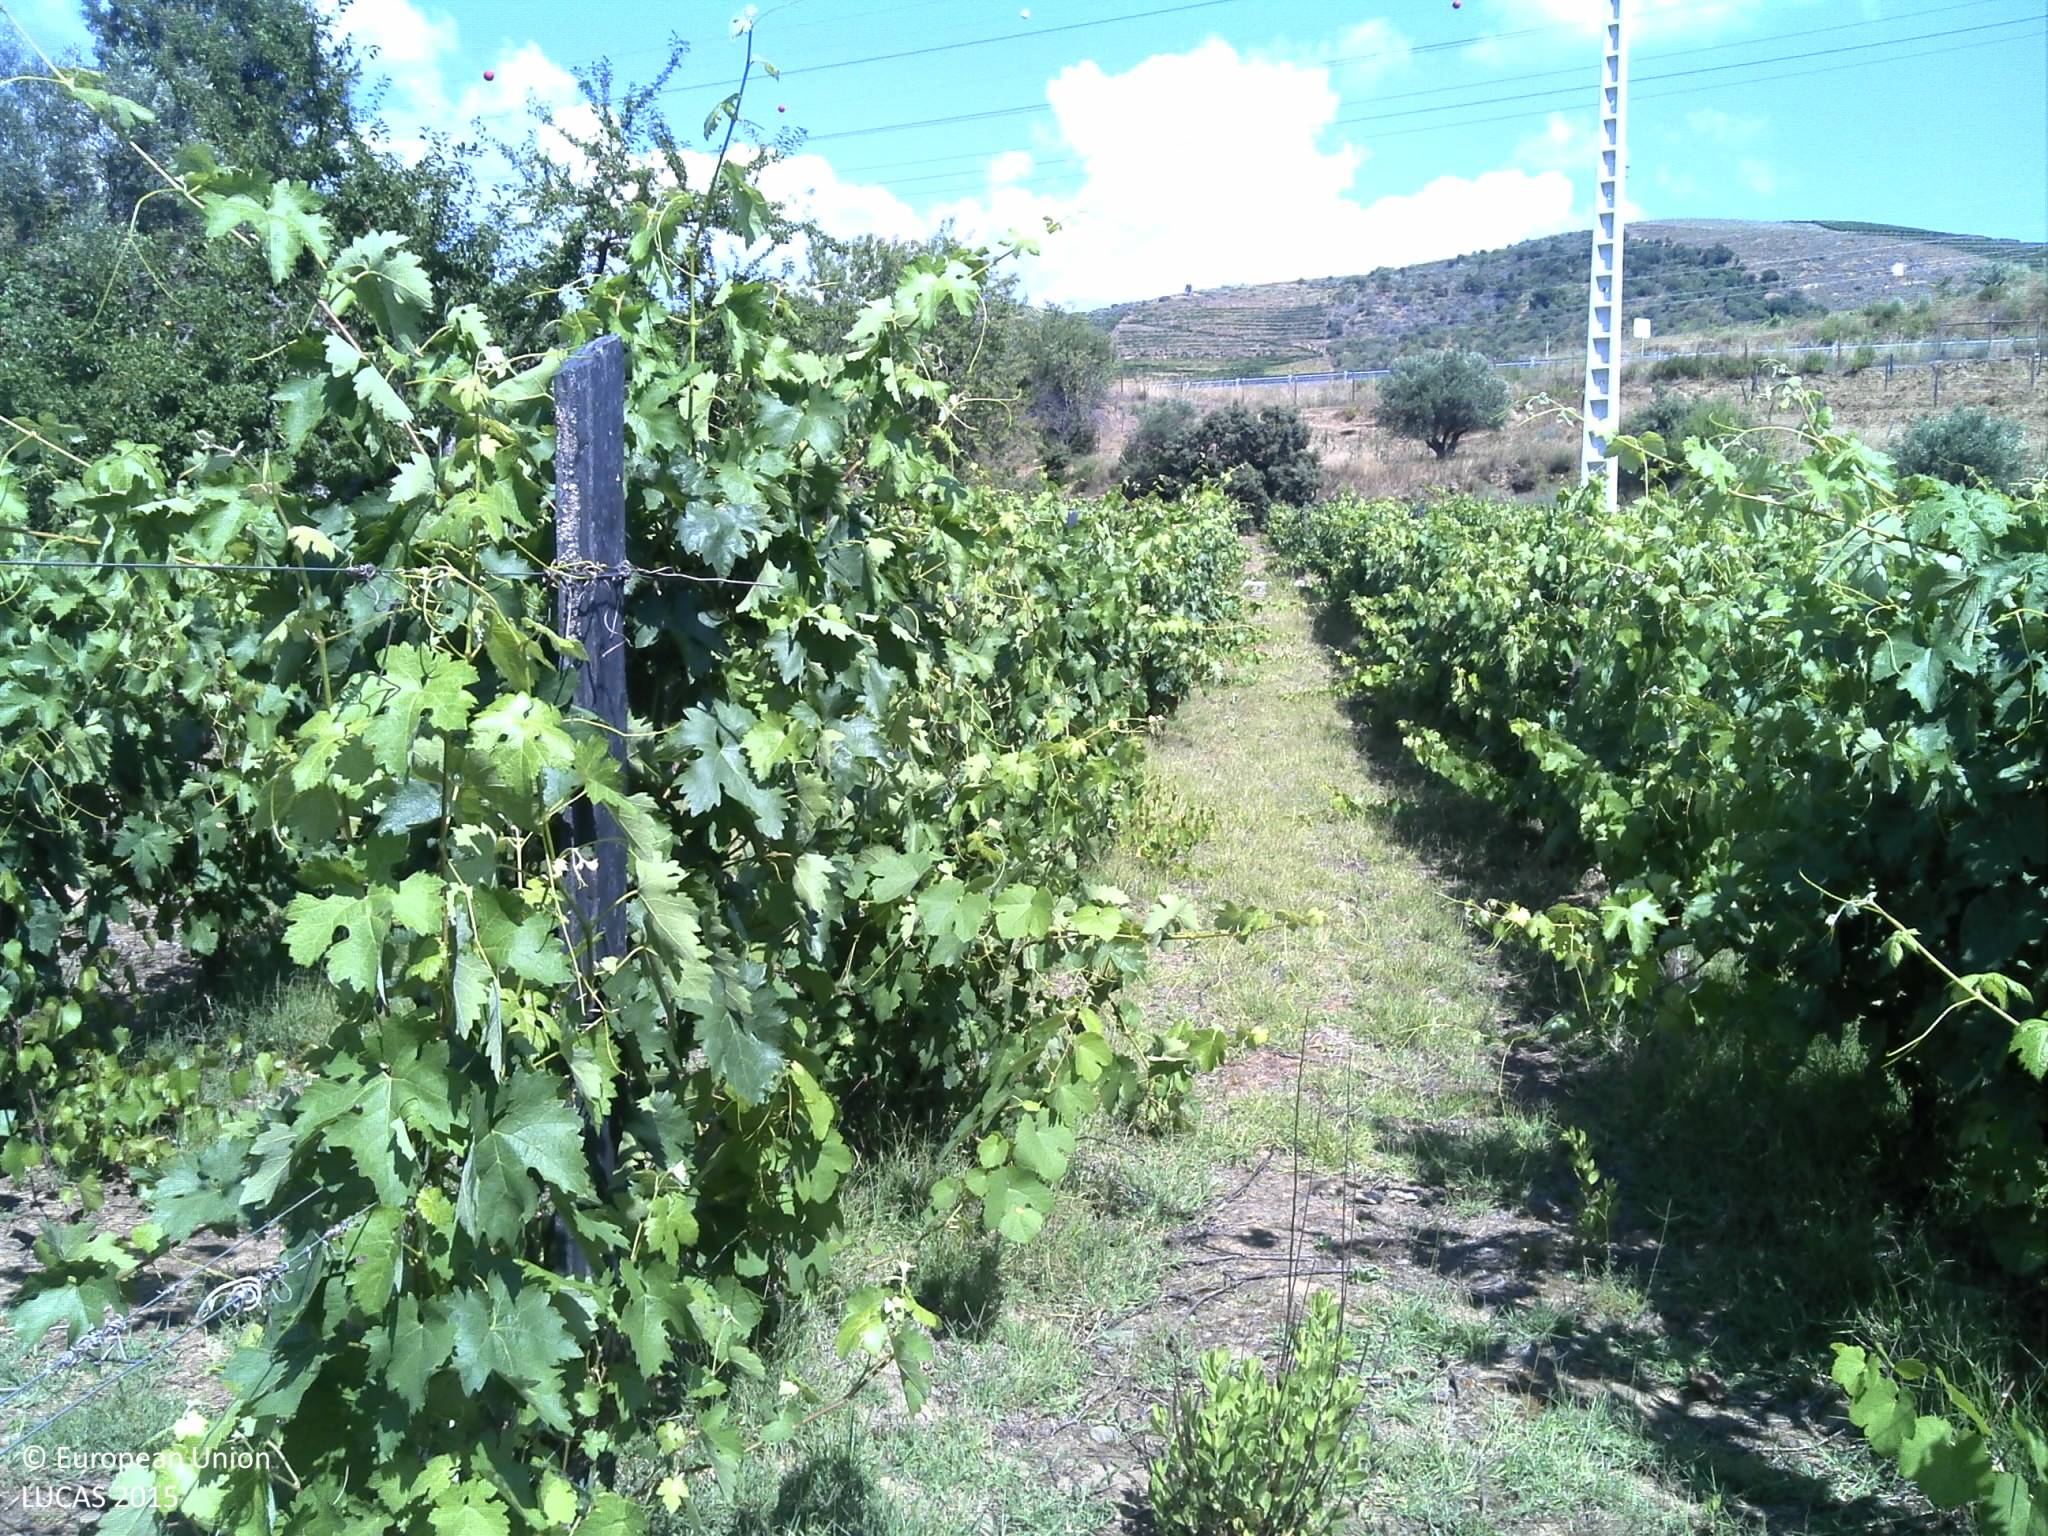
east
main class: Cropland
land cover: Vineyards
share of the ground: 25 - 50 %
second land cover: Grassland without tree/shrub cover
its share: 25 - 50 %
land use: Agriculture (excluding fallow land and kitchen gardens)
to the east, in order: Vineyards; Grassland without tree/shrub cover; Vineyards; Electric lines; Vineyards; Olive groves; Tracks; Olive groves; Nuts trees; Olive groves; Nuts trees; Electric lines; Nuts trees; Olive groves; Fences; Grassland without tree/shrub cover; Paved roads, cycling and walking lanes; Electric lines; Grassland without tree/shrub cover; Fences; Grass margins; Tracks; Grass margins; Shruby margins; Olive groves; Vineyards
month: June
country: PT
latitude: 41.1260
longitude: -7.1332
